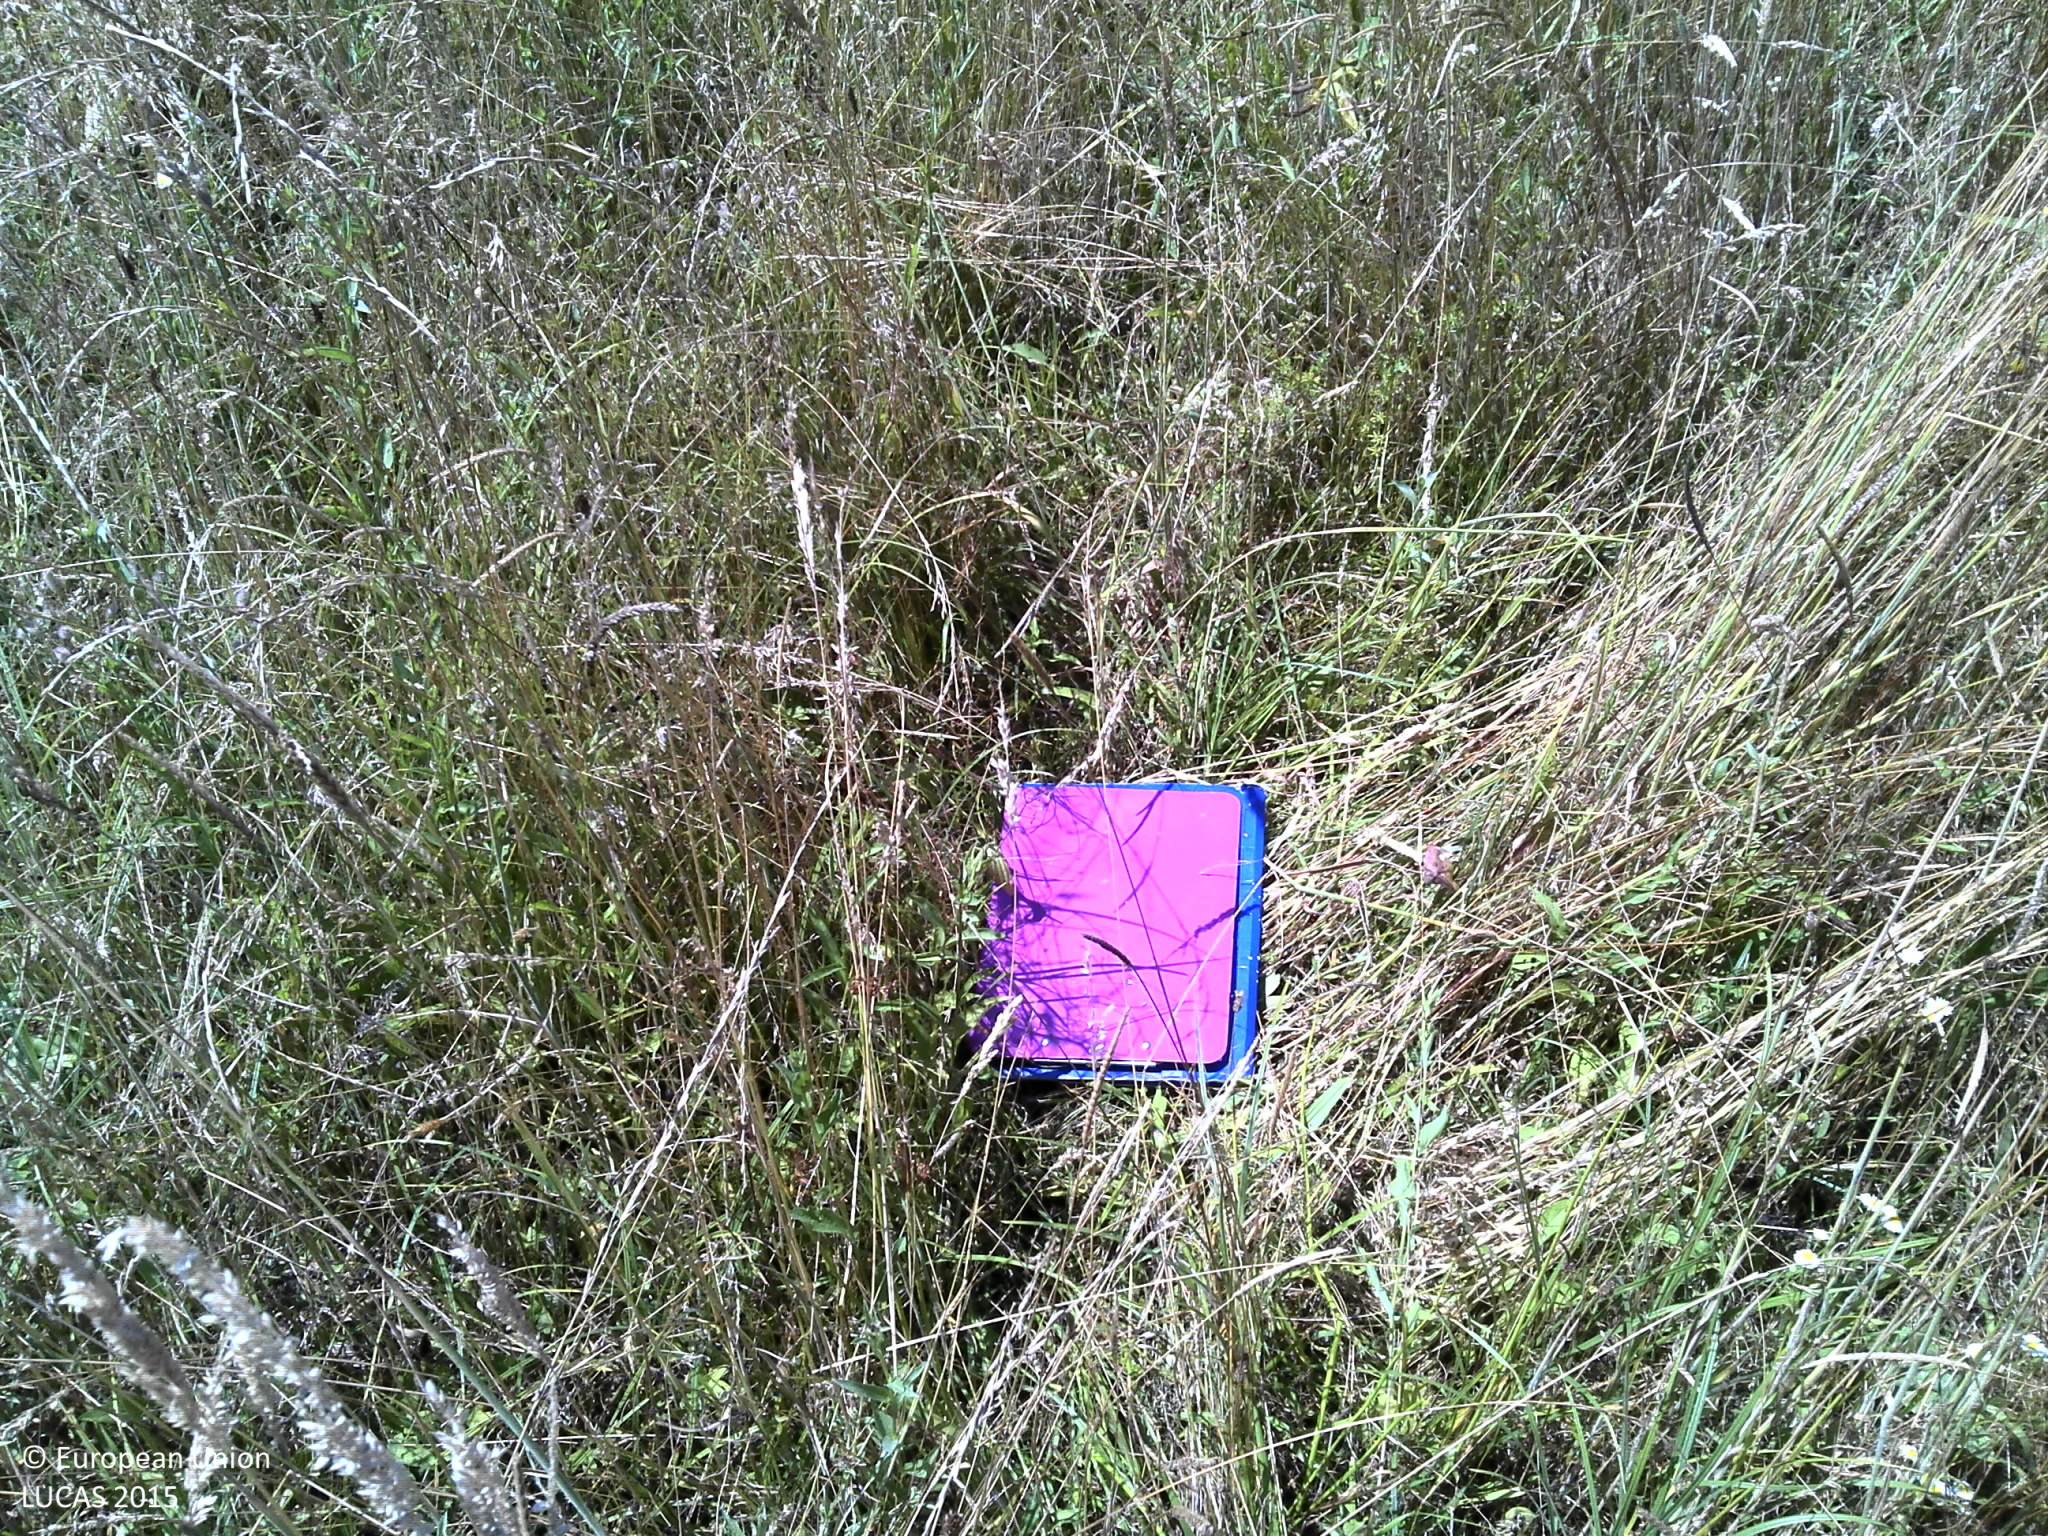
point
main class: Grassland
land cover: Grassland without tree/shrub cover
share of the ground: > 75 %
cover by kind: herbaceous plants 100 %
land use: Semi-natural and natural areas not in use
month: July
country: HR
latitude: 45.4273
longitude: 16.8368
